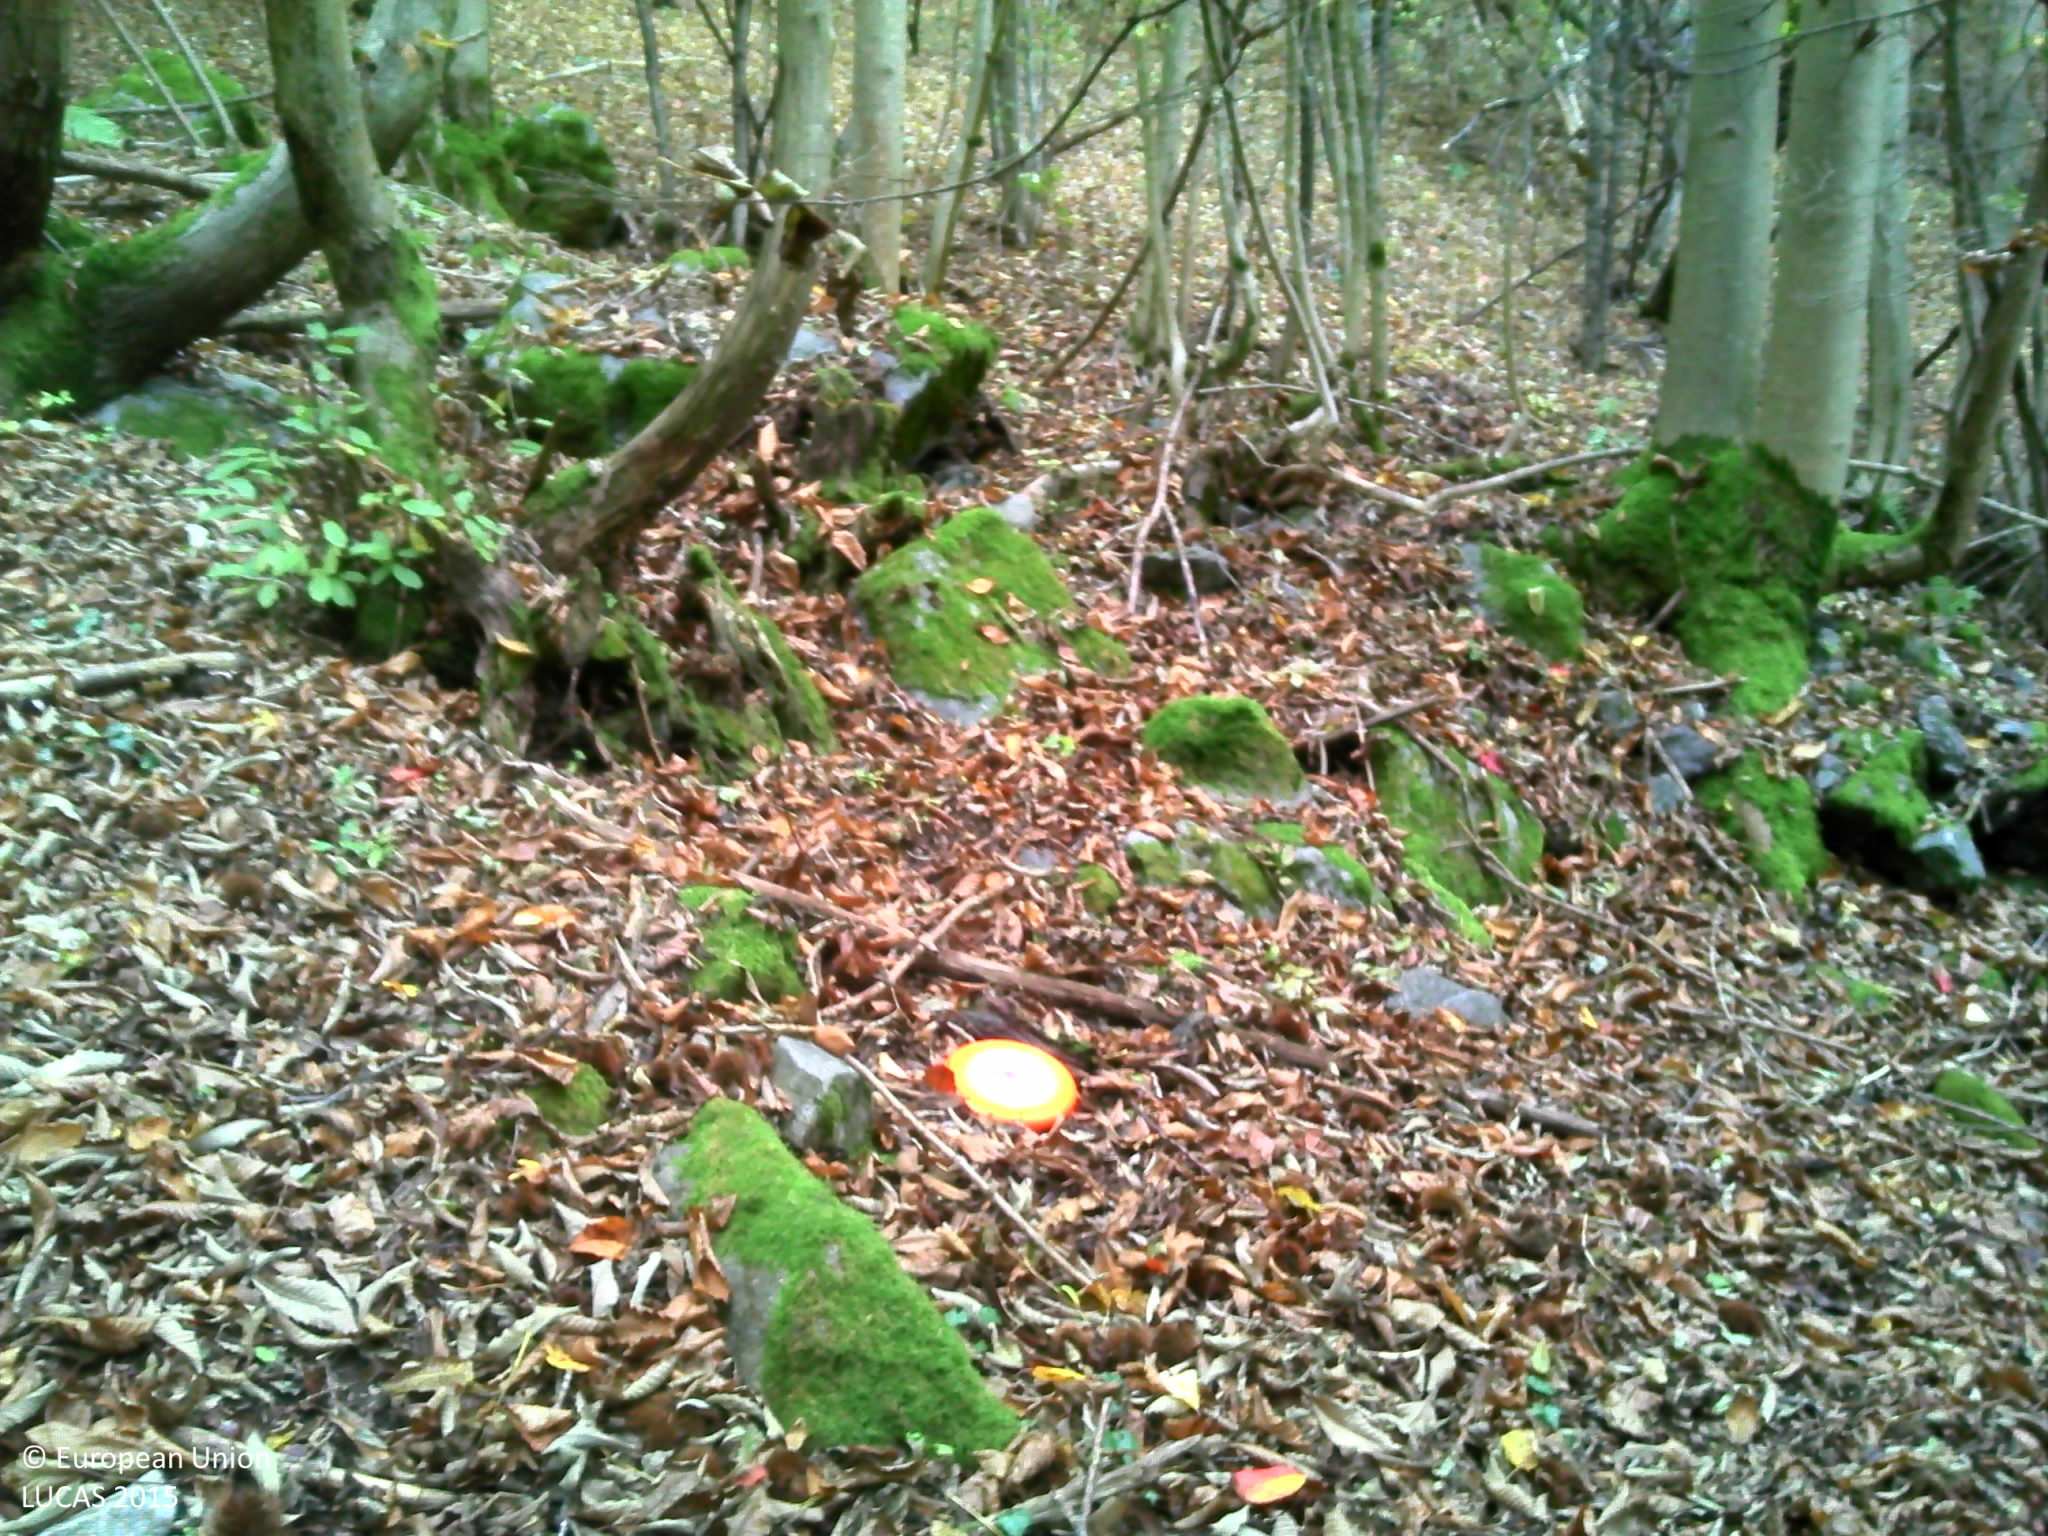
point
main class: Woodland
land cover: Broadleaved woodland
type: mesophytic deciduous forest
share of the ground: > 75 %
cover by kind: broadleaved forest trees 75 %, coniferous forest trees 15 %, unconsolidated bare surface 10 %
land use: Forestry
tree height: > 5 m
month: October
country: FR
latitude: 45.4202
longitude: 6.2604
